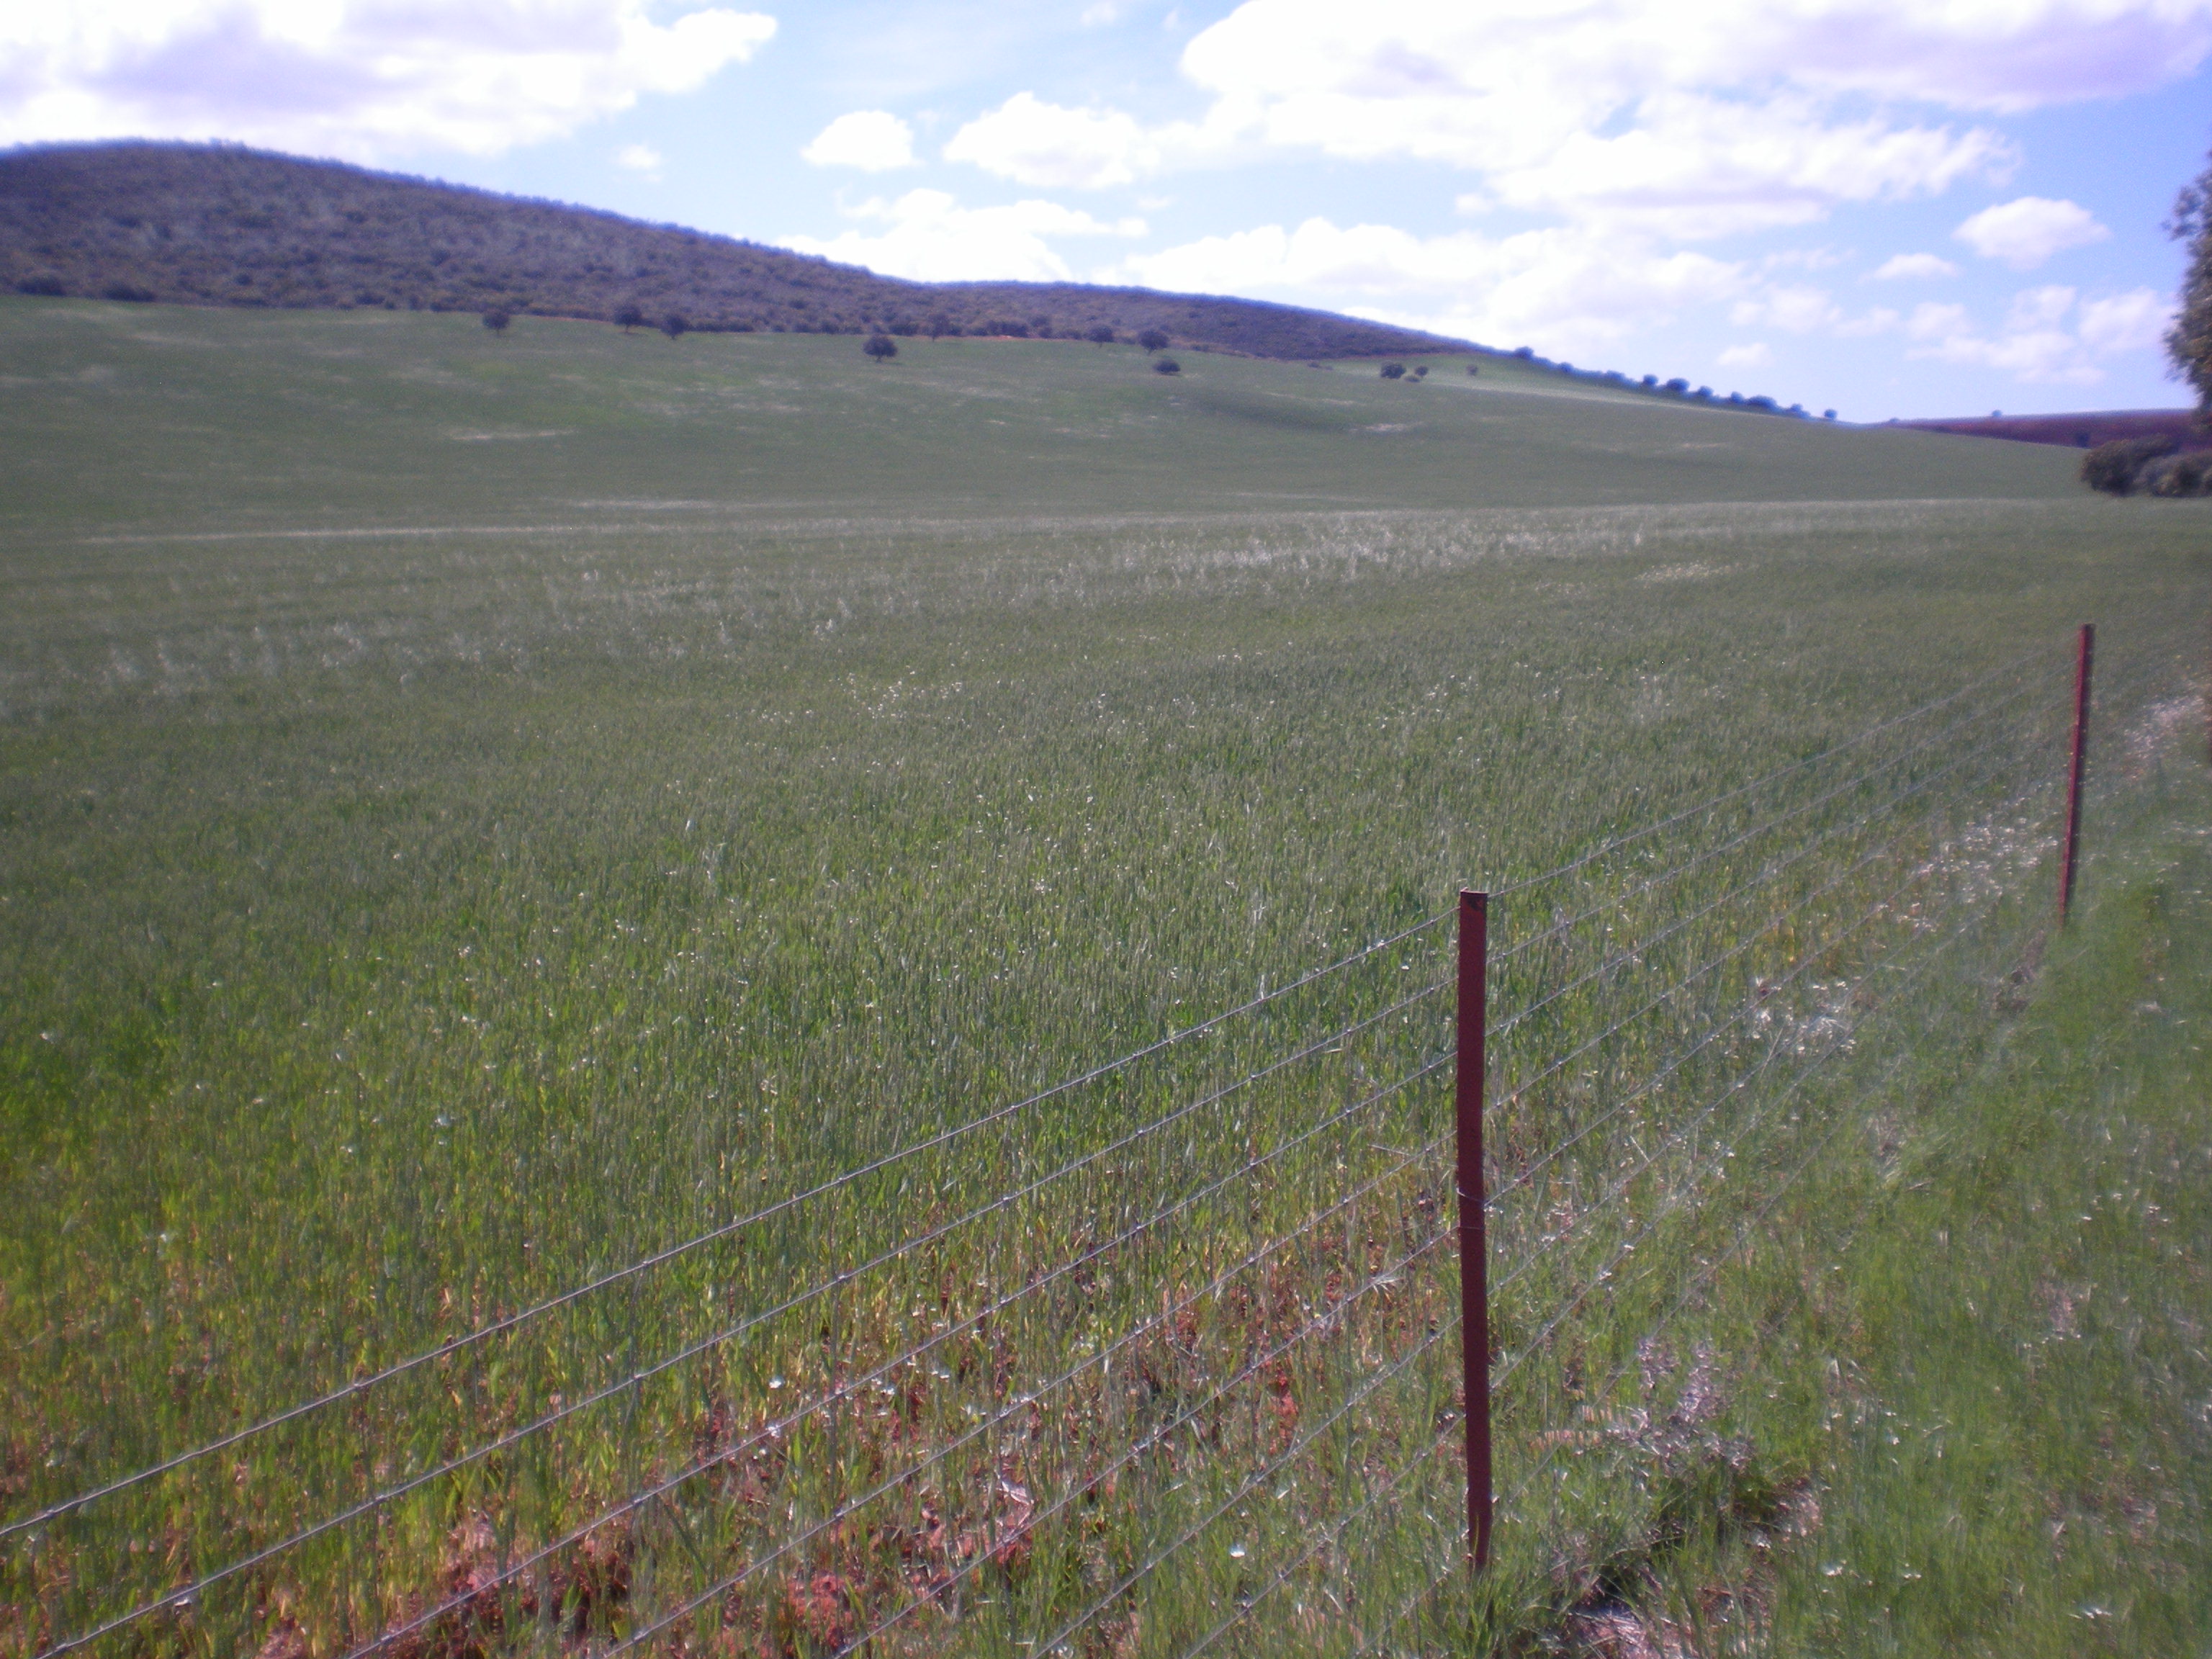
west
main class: Cropland
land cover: Common wheat
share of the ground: > 75 %
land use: Agriculture (excluding fallow land and kitchen gardens)
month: April
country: ES
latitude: 38.7503
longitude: -3.5789
